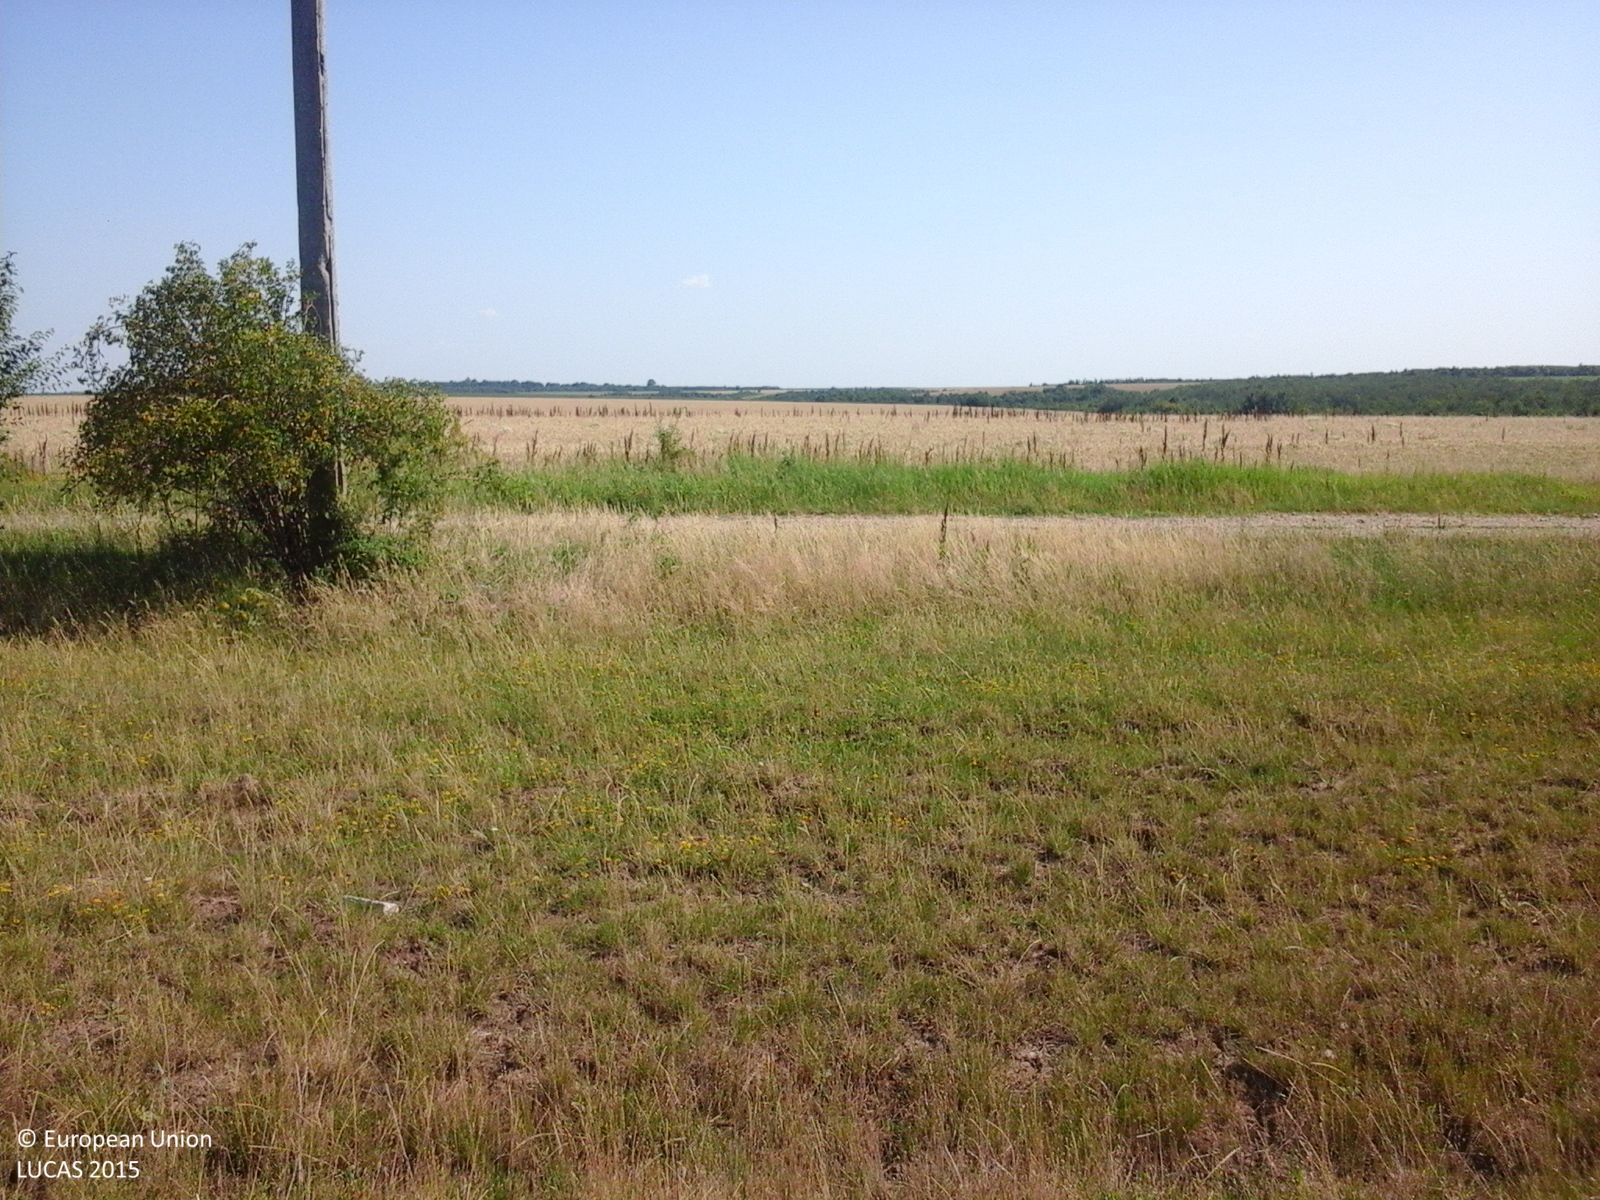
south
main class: Cropland
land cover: Maize
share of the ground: < 10 %
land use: Agriculture (excluding fallow land and kitchen gardens)
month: July
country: RO
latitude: 44.5506
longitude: 24.6384
